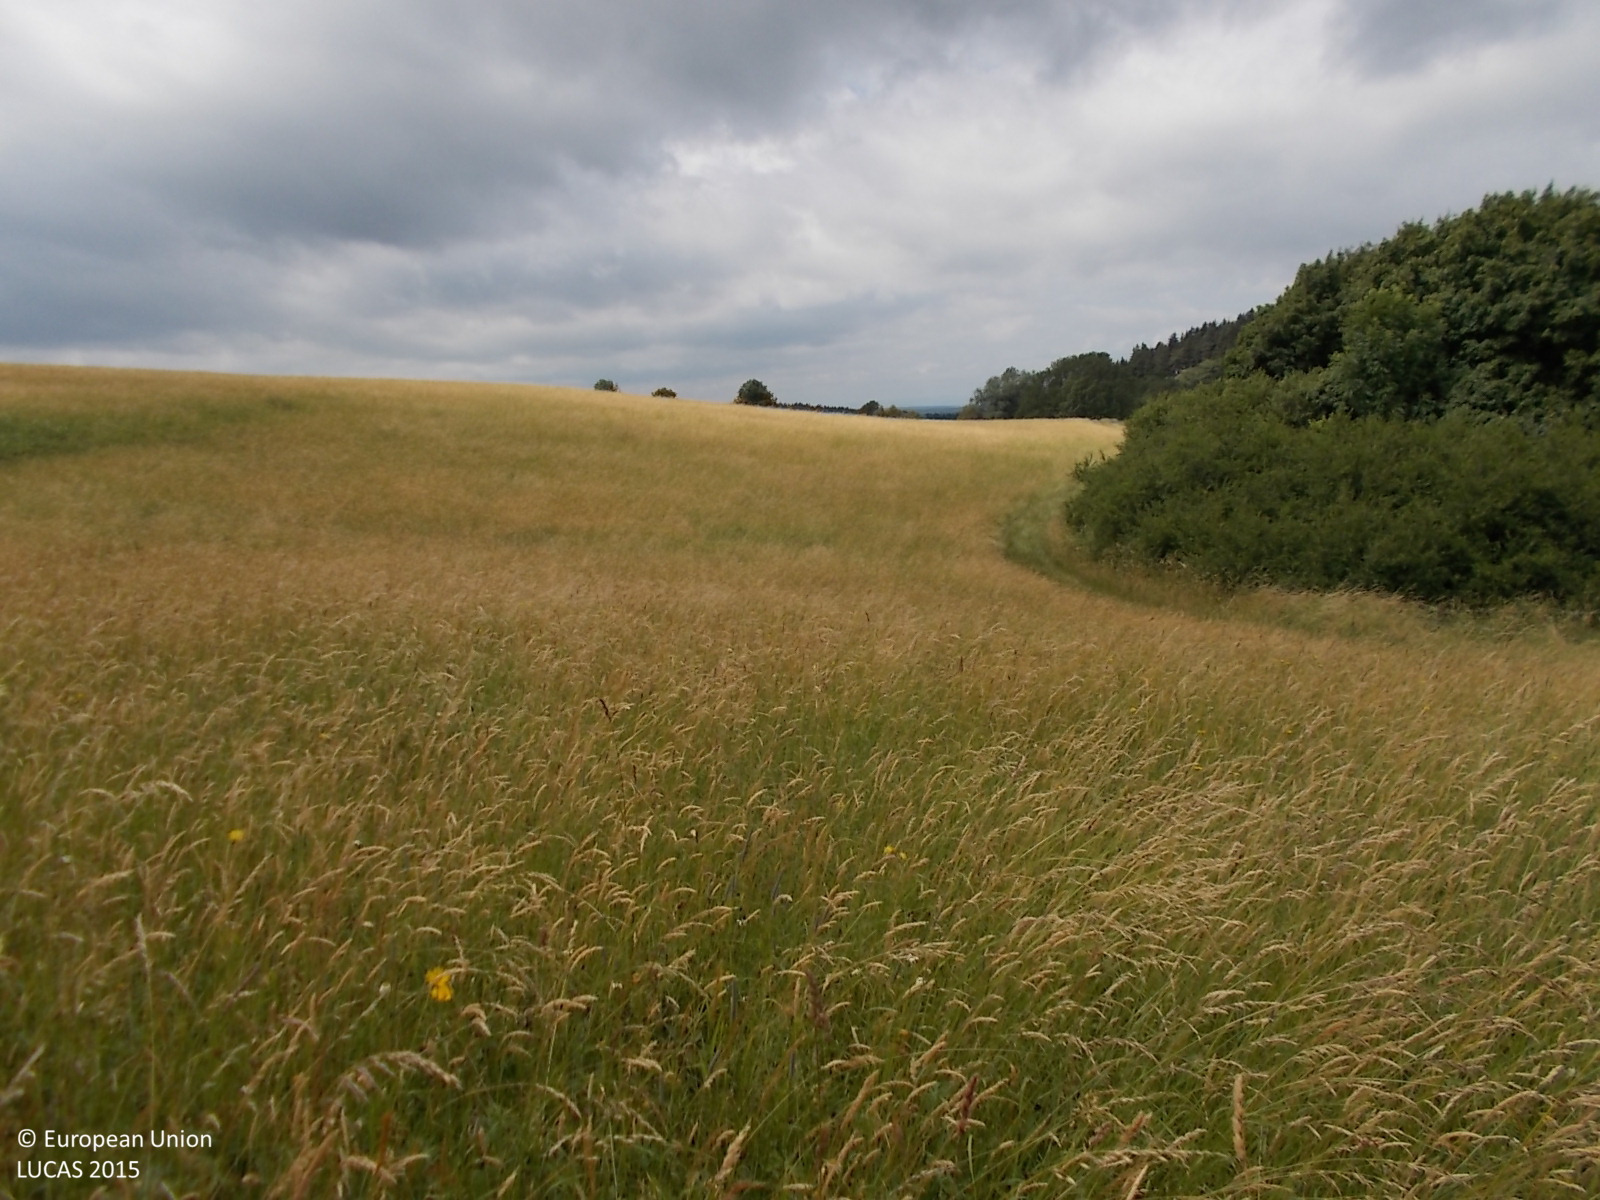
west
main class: Grassland
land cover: Grassland without tree/shrub cover
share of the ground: > 75 %
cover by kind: herbaceous plants 100 %
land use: Agriculture (excluding fallow land and kitchen gardens)
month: June
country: CZ
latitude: 49.3826
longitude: 17.6856
